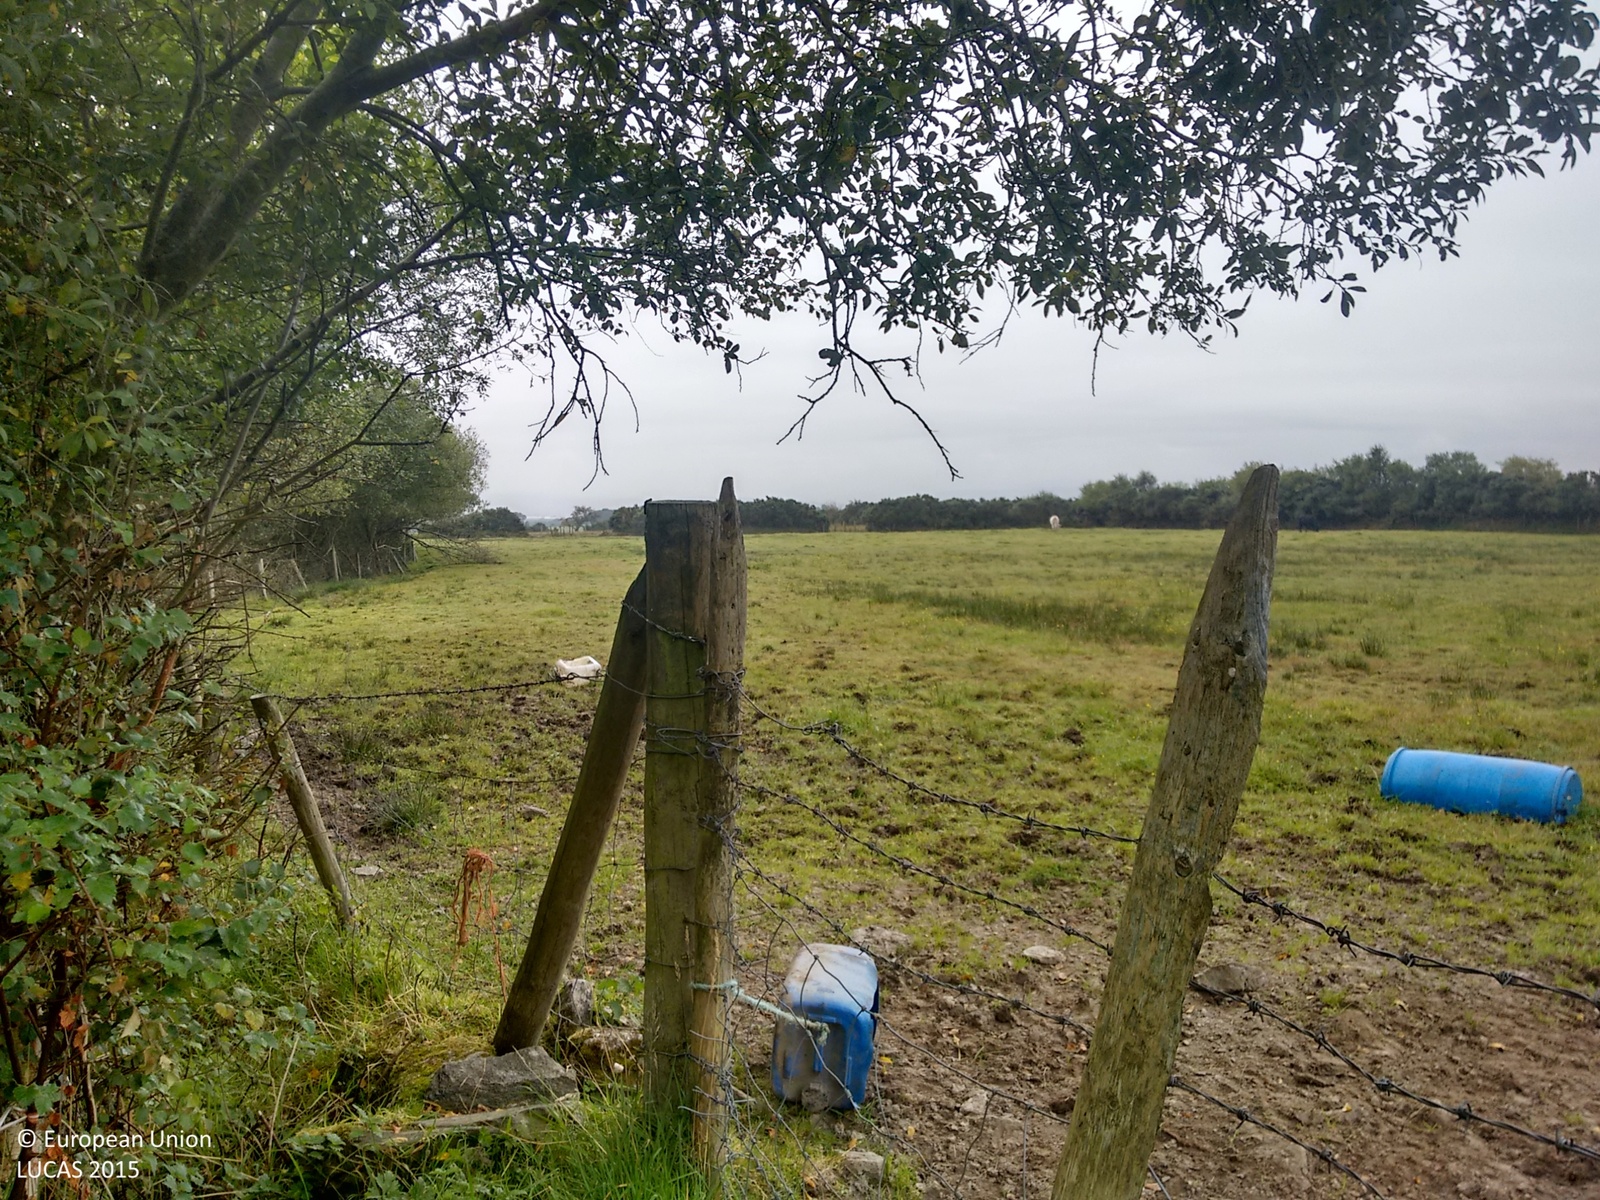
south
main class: Grassland
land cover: Grassland without tree/shrub cover
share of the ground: > 75 %
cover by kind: herbaceous plants 100 %
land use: Agriculture (excluding fallow land and kitchen gardens)
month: September
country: IE
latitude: 55.0729
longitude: -7.2964
